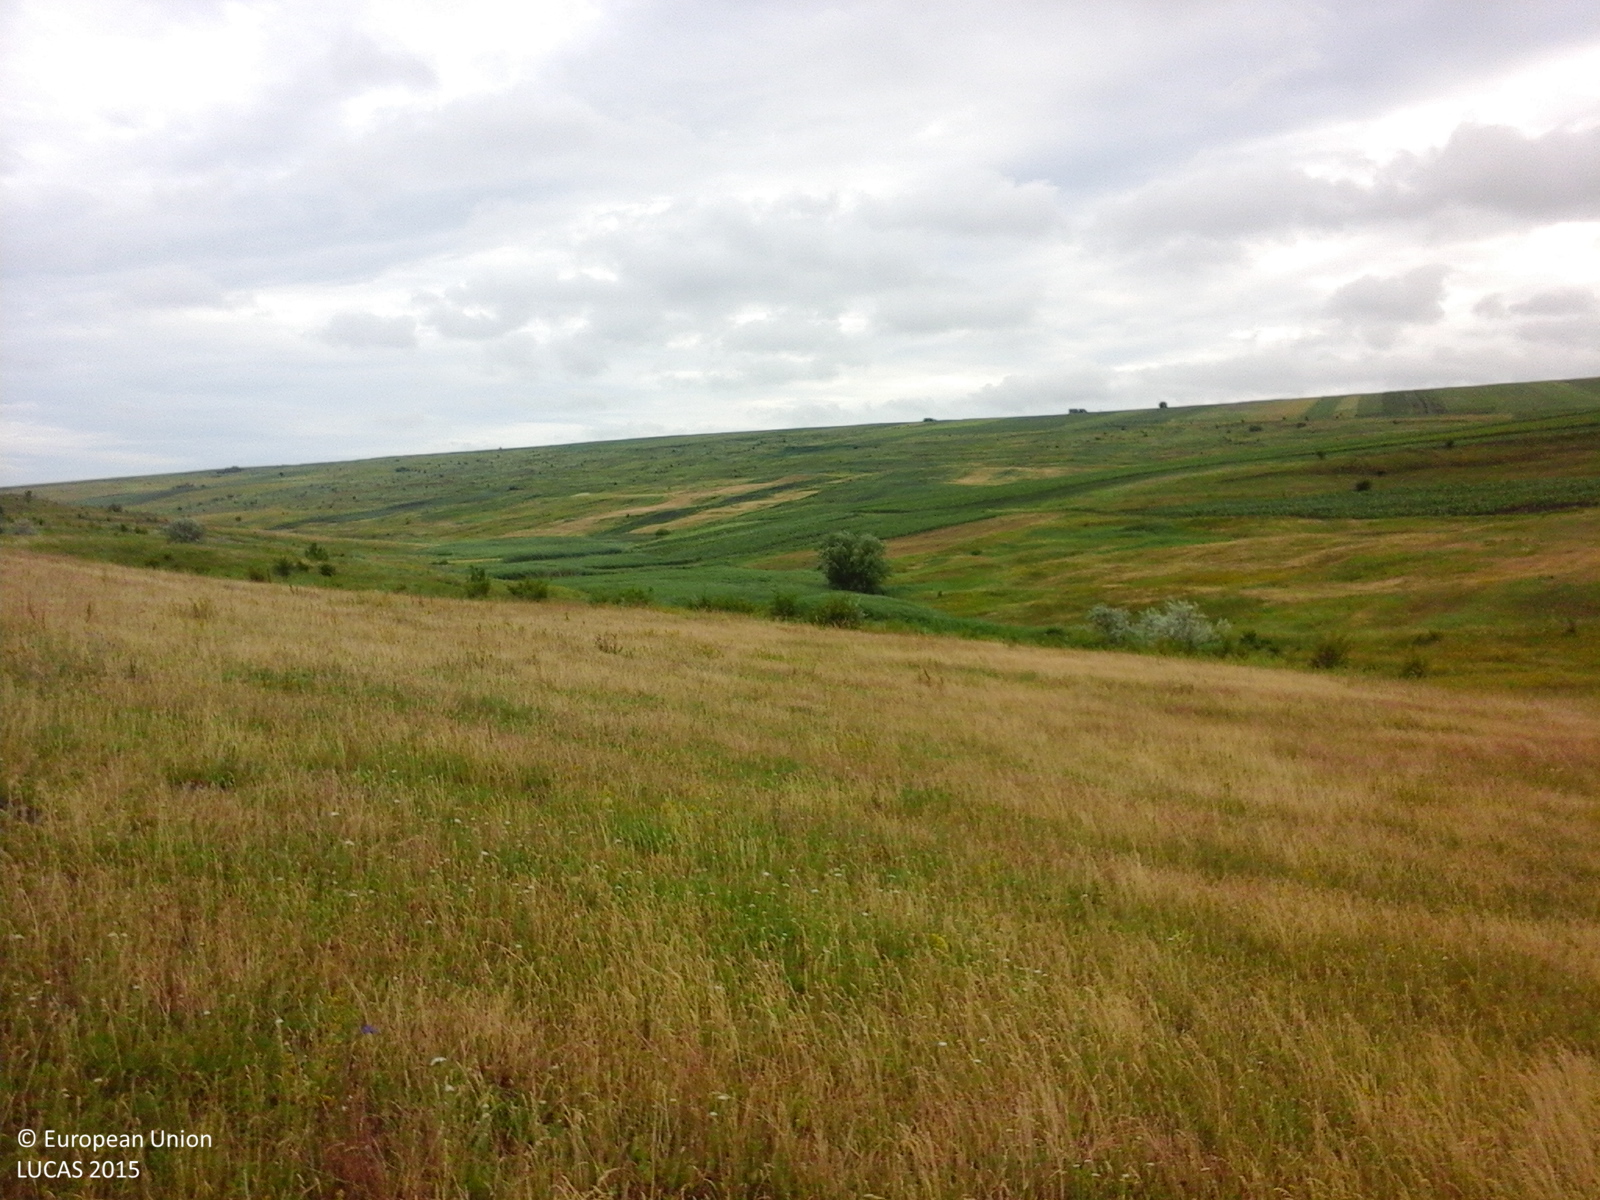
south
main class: Grassland
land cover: Grassland without tree/shrub cover
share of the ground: > 75 %
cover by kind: herbaceous plants 100 %
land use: Agriculture (excluding fallow land and kitchen gardens)
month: June
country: RO
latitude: 47.9112
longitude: 26.7014
